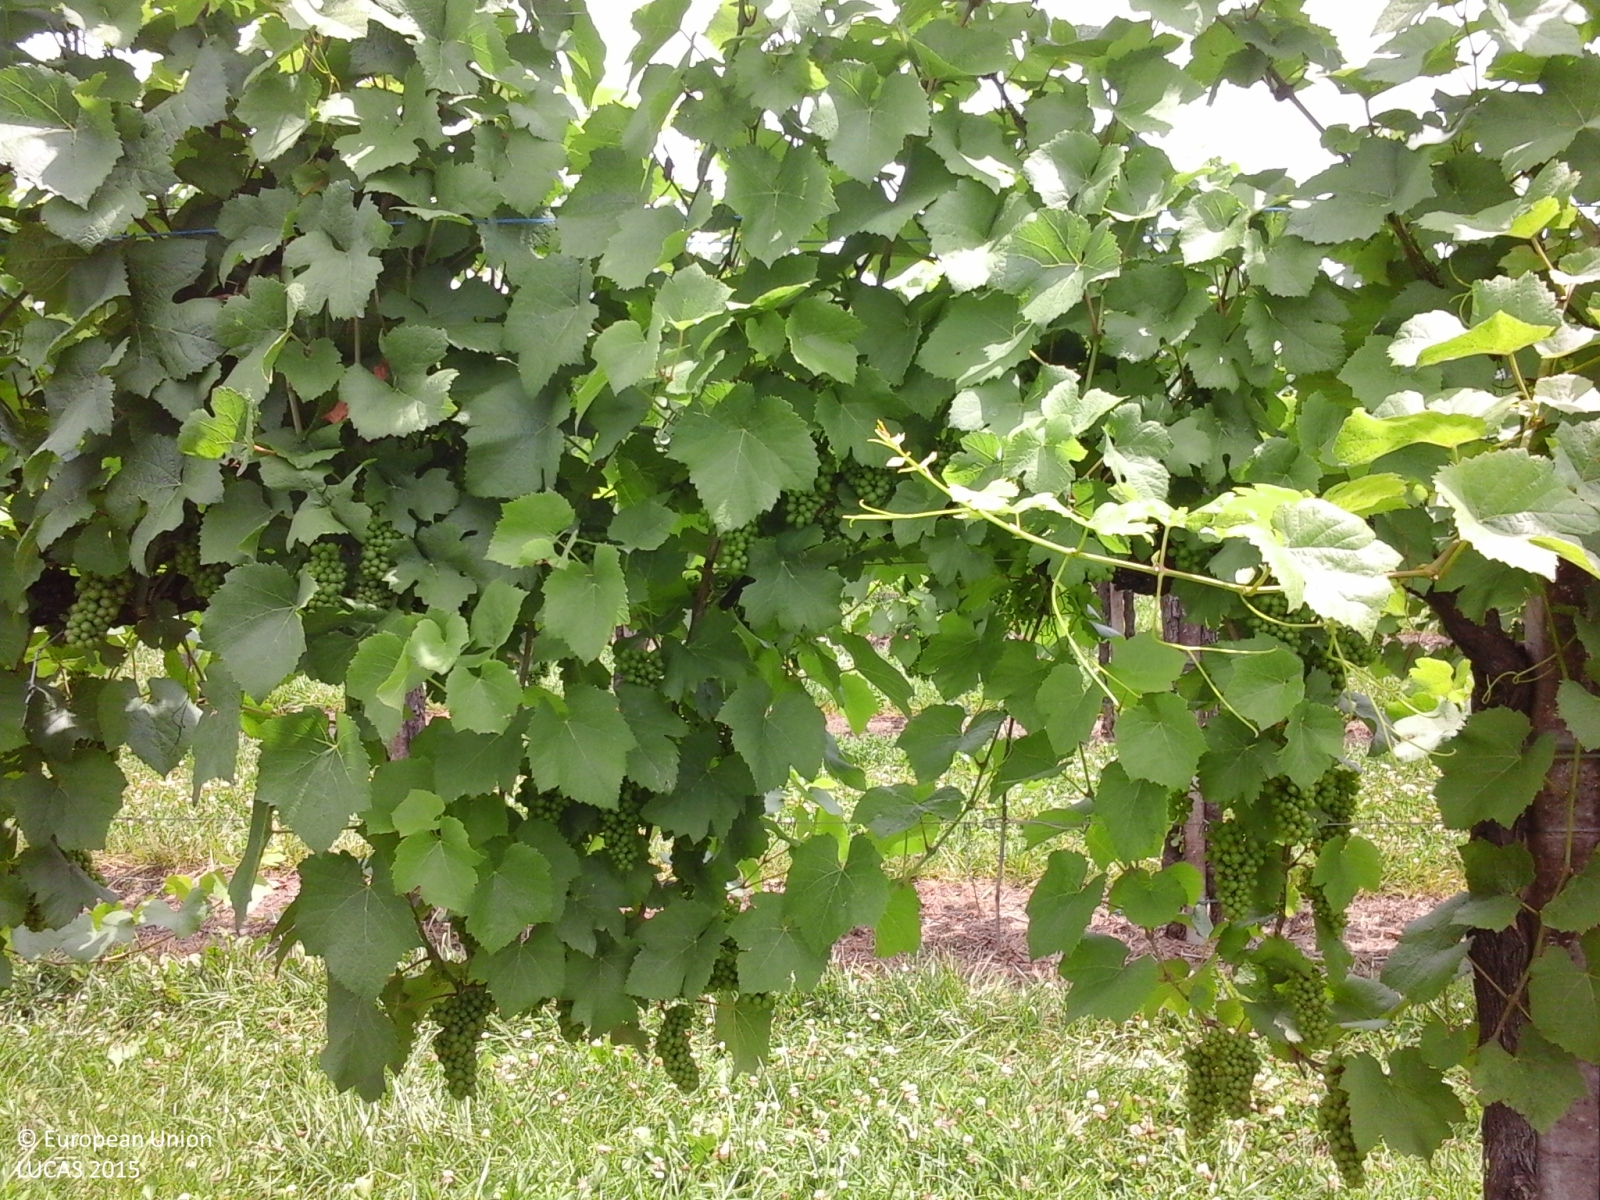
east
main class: Cropland
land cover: Vineyards
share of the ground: 25 - 50 %
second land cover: Grassland without tree/shrub cover
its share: > 75 %
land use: Agriculture (excluding fallow land and kitchen gardens)
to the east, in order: Vineyards; Grassland without tree/shrub cover
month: June
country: IT
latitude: 45.7266
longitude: 12.5278
